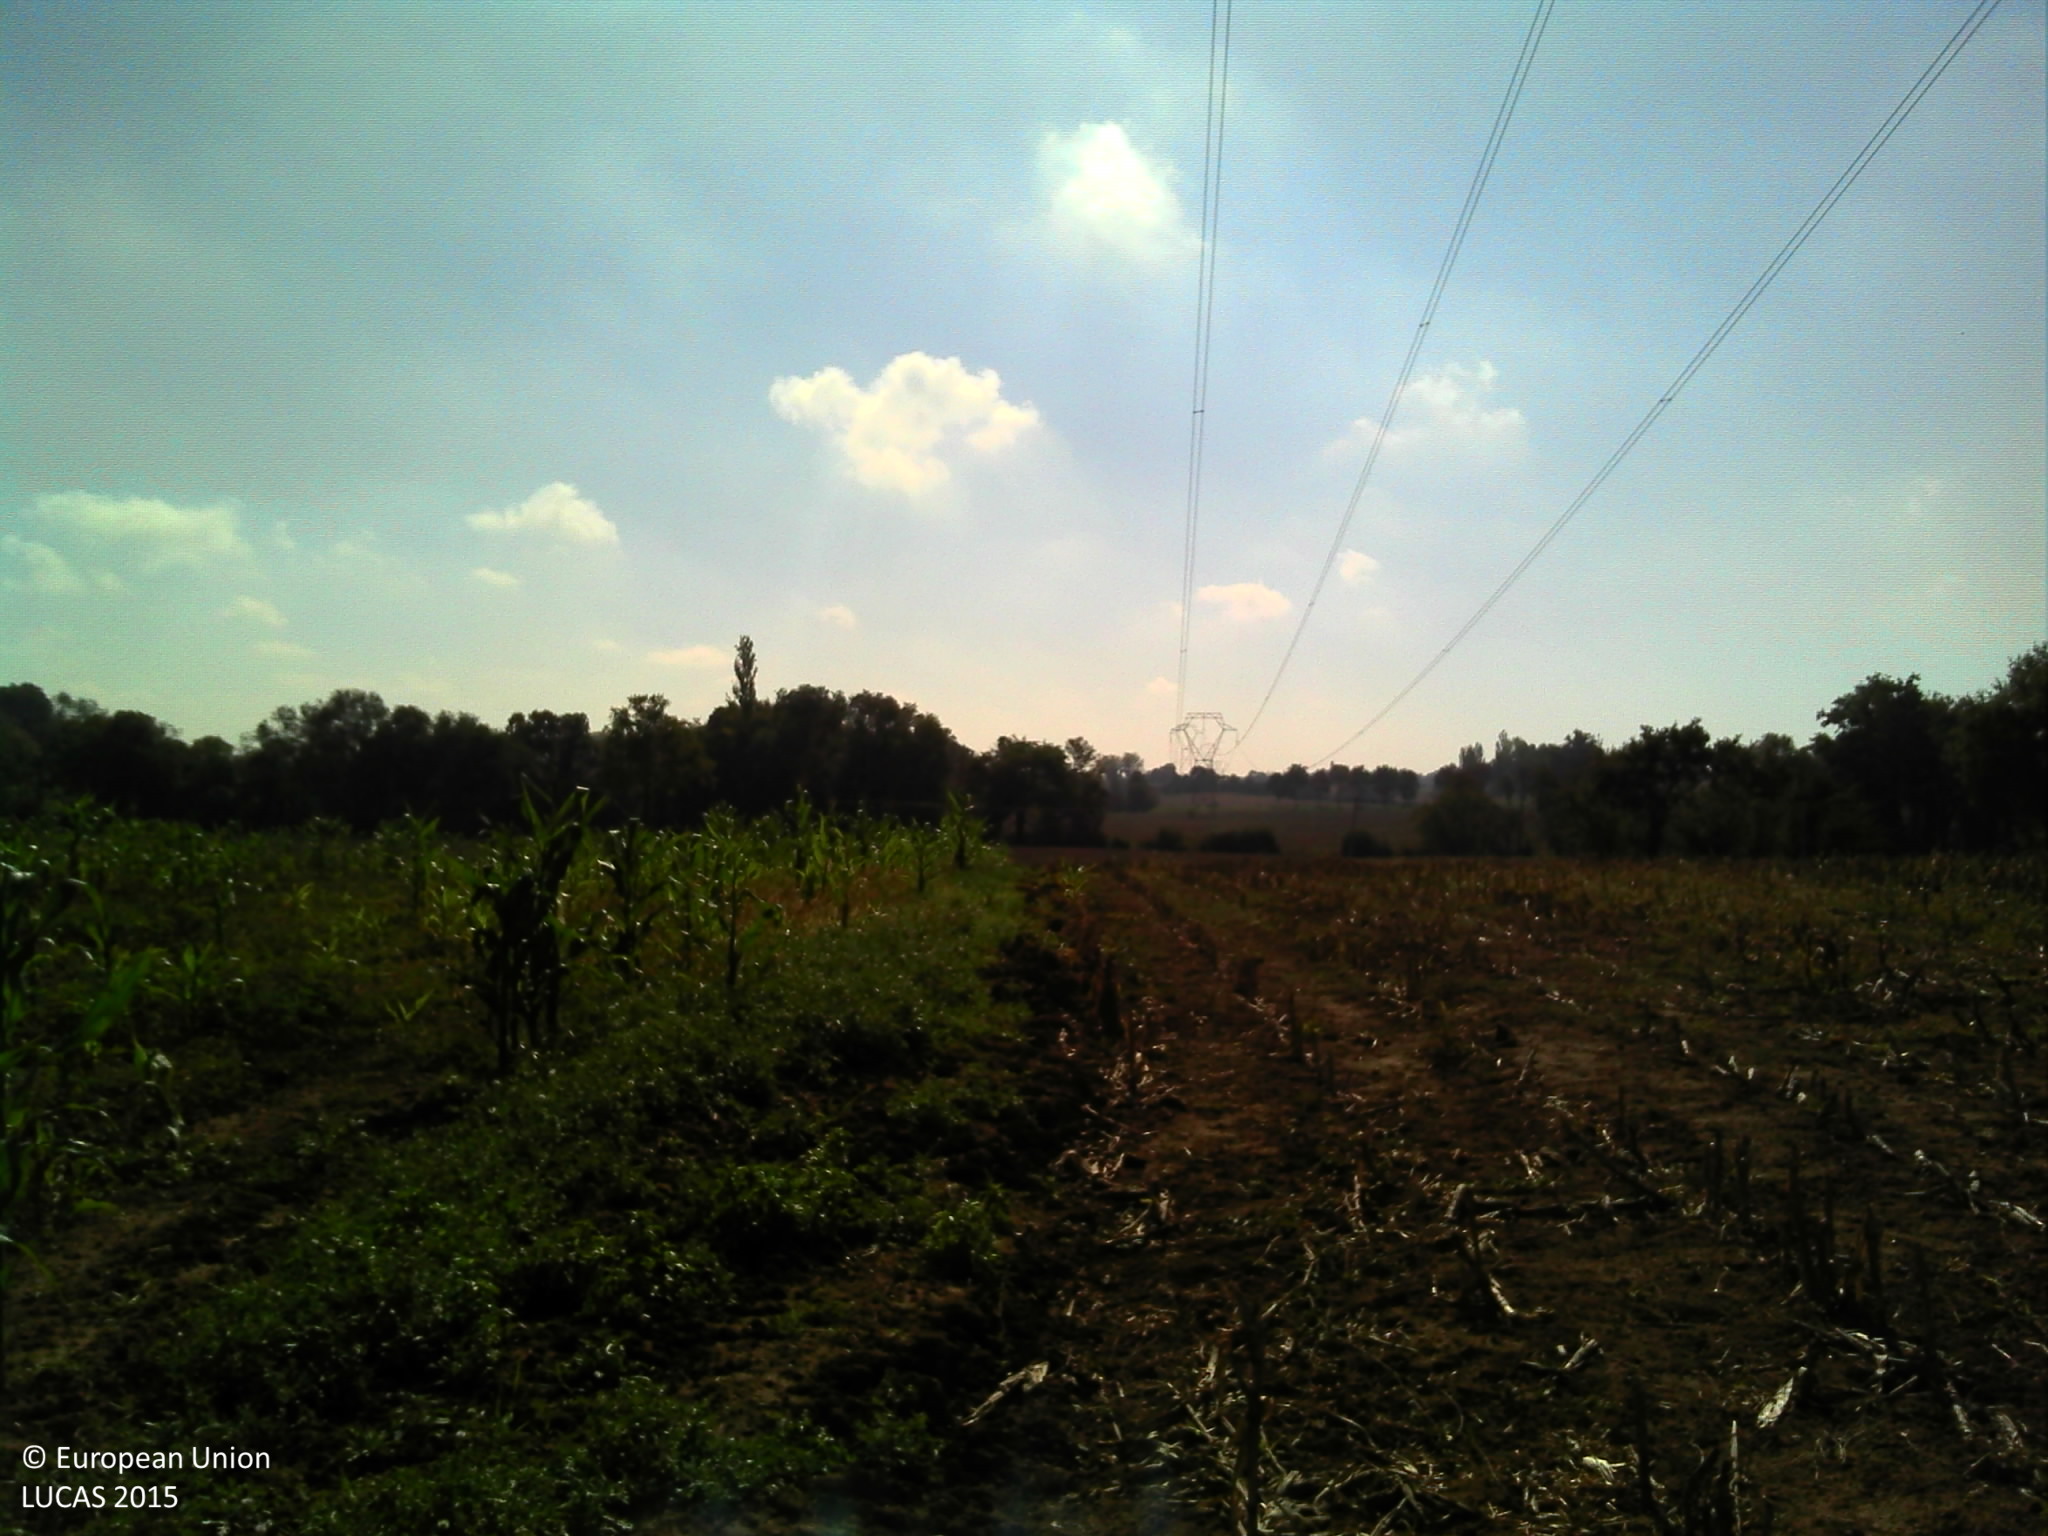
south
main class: Cropland
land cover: Maize
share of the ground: < 10 %
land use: Agriculture (excluding fallow land and kitchen gardens)
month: October
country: FR
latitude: 46.2479
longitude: 4.9051
